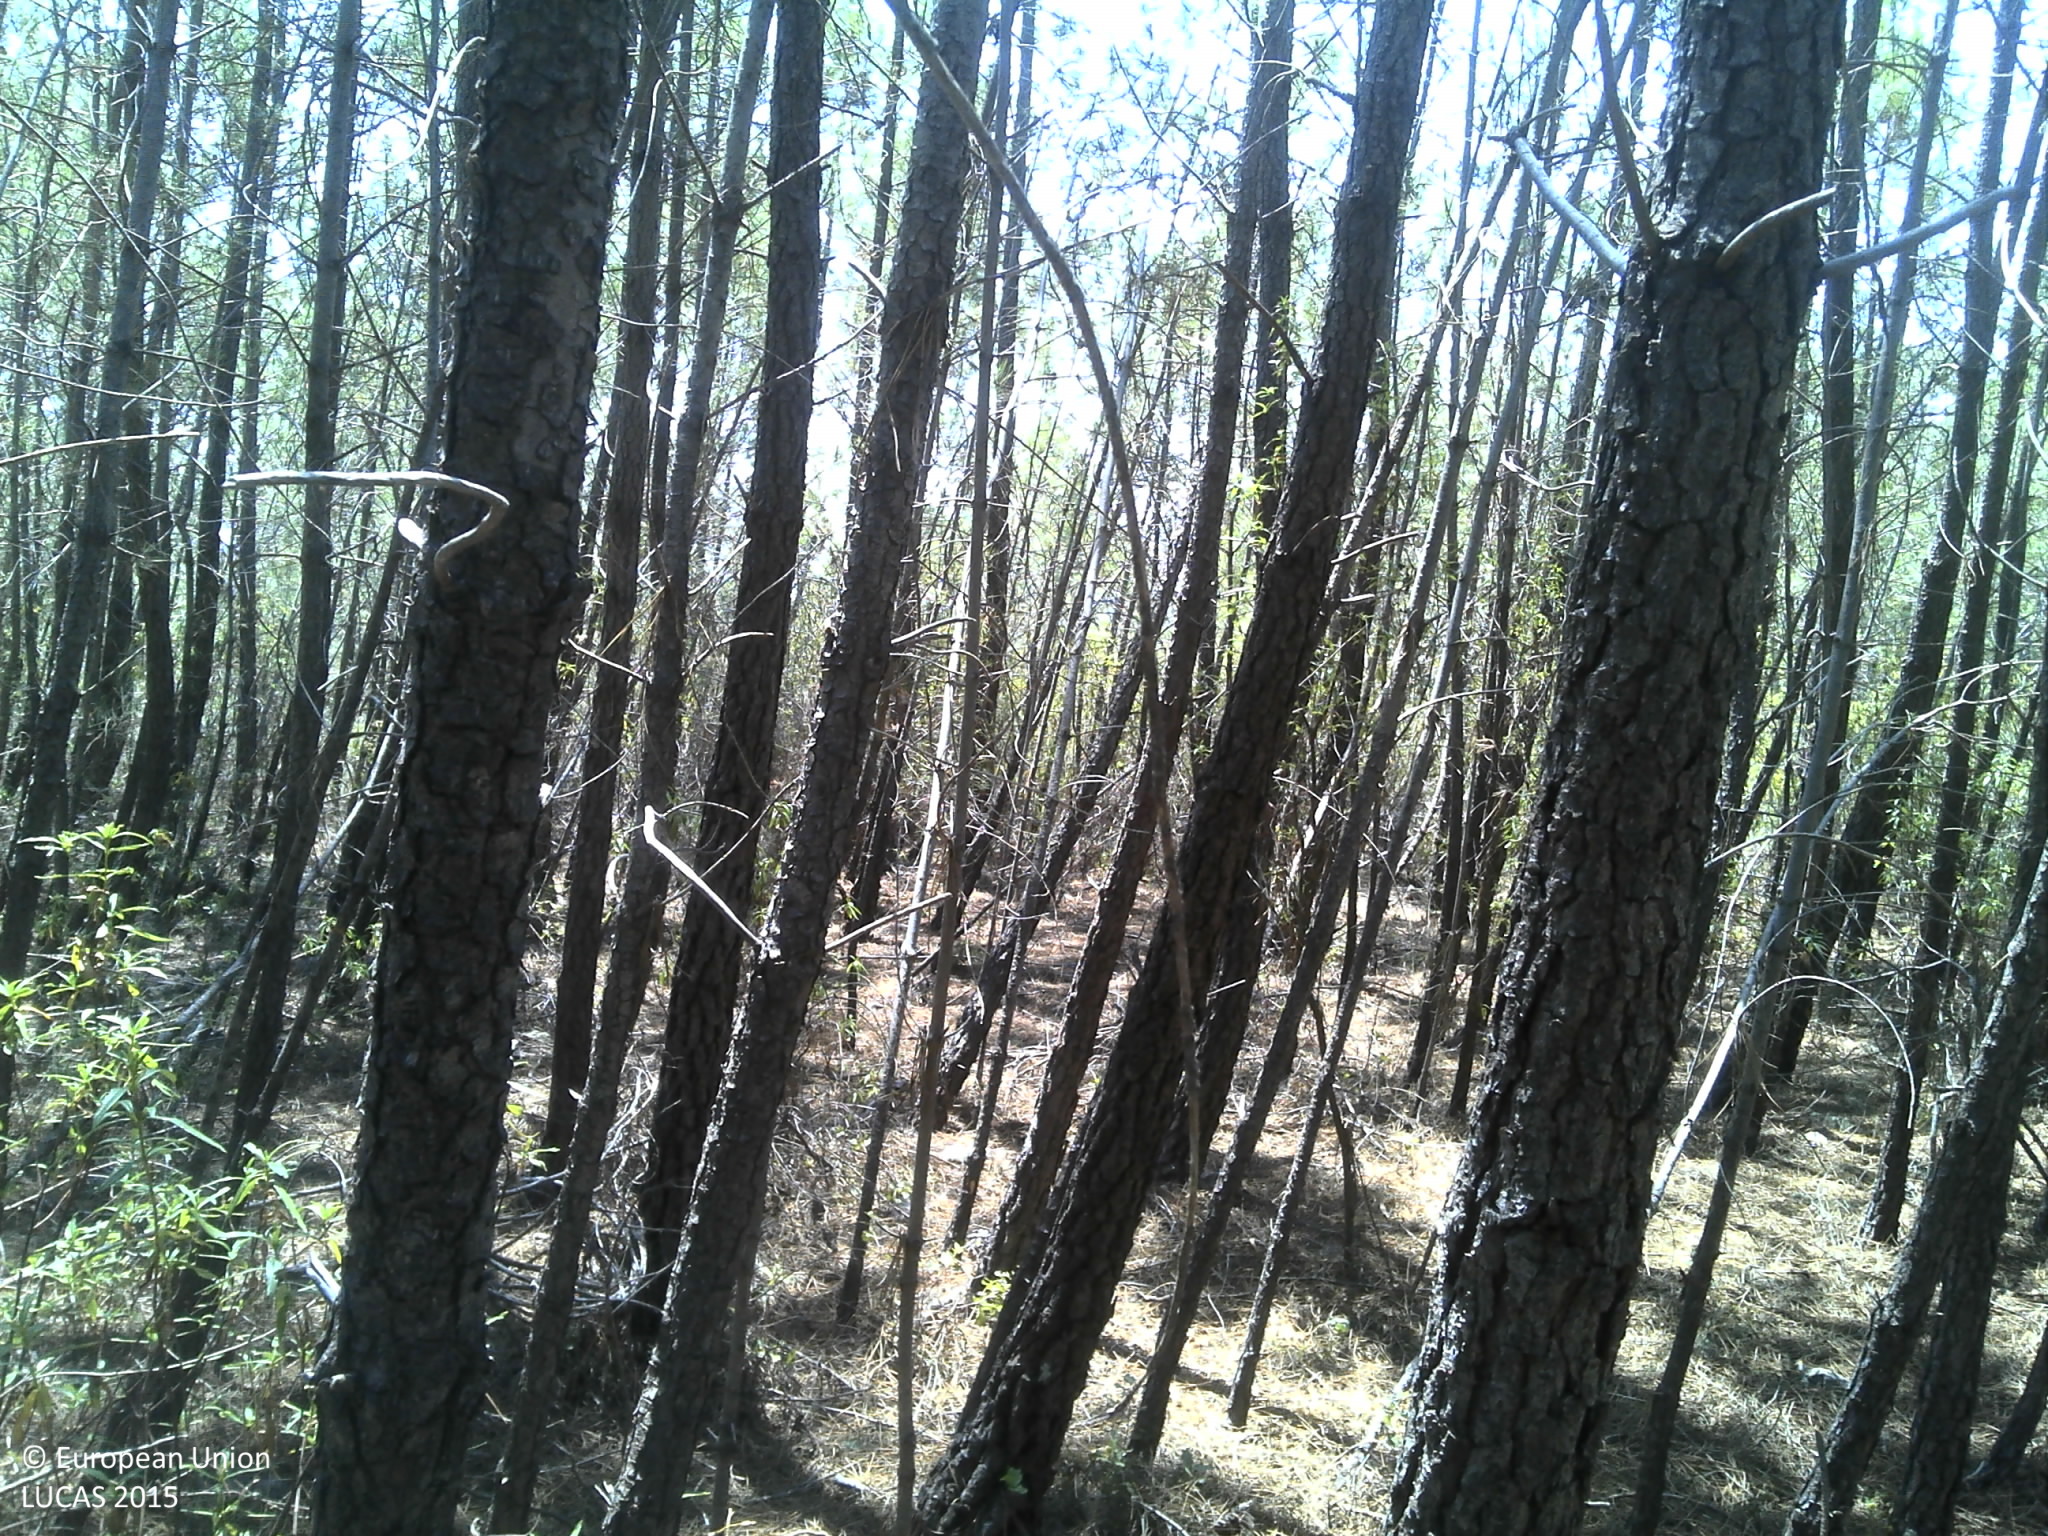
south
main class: Woodland
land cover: Pine dominated coniferous woodland
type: coniferous forest of the mediterranean region
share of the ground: > 75 %
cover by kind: coniferous forest trees 80 %, shrubs 5 %, herbaceous plants 5 %, unconsolidated bare surface 5 %
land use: Forestry
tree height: > 5 m
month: June
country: PT
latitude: 40.0525
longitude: -7.0547
